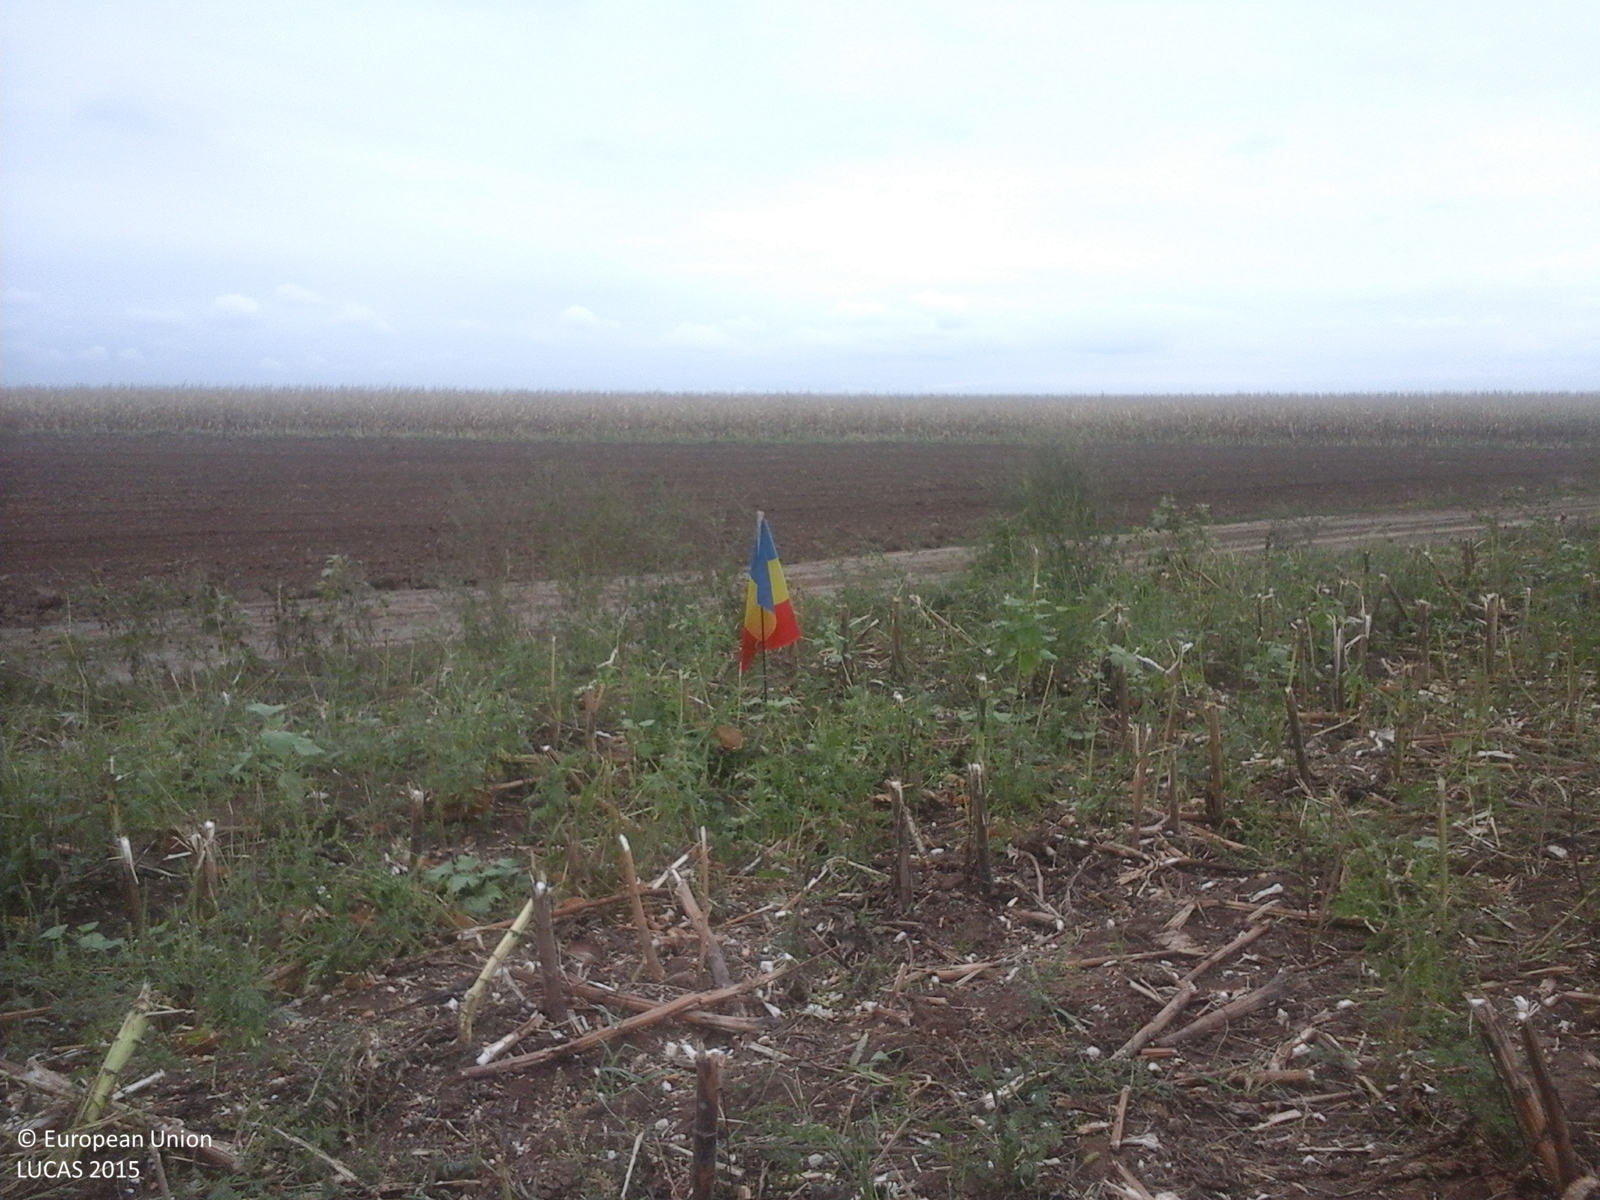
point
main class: Cropland
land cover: Sunflower
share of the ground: < 10 %
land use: Agriculture (excluding fallow land and kitchen gardens)
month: September
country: RO
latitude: 47.3497
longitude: 21.9755
